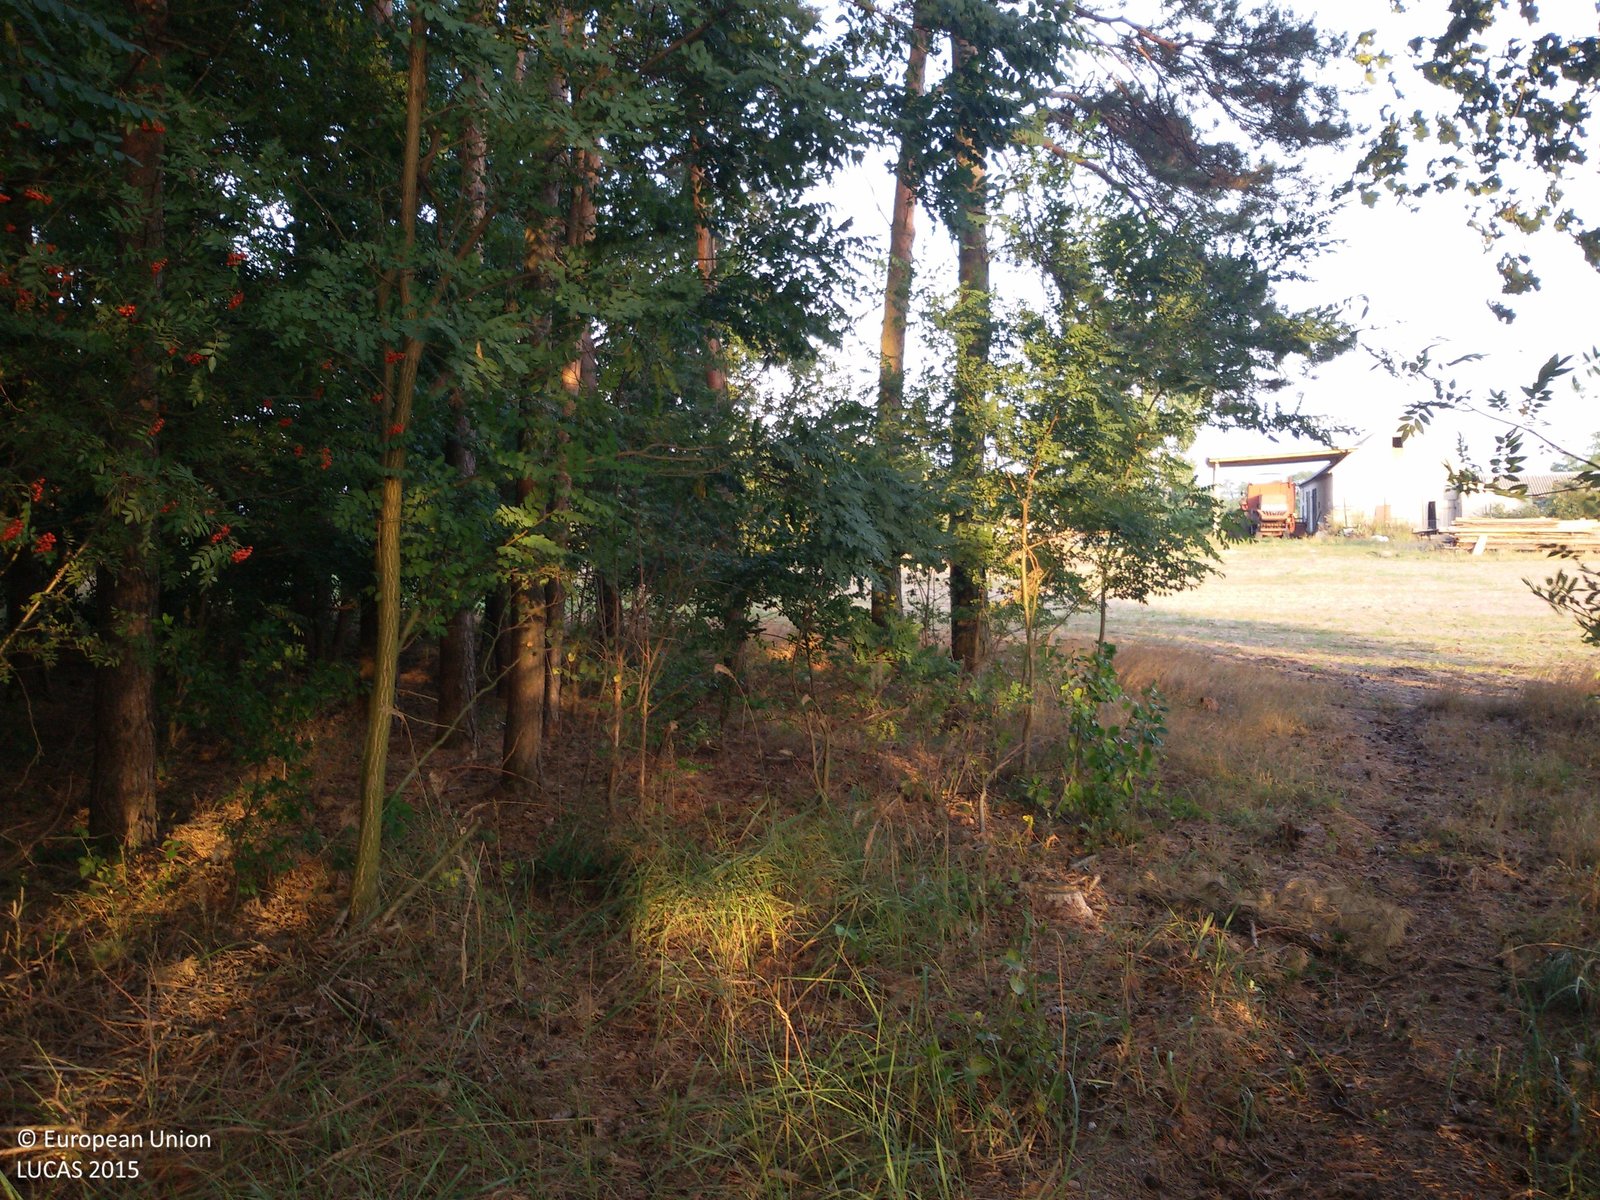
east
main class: Woodland
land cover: Pine dominated coniferous woodland
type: hemiboreal forest and nemoral coniferous forest and mixed broadleaved-coniferous forest
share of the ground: > 75 %
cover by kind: coniferous forest trees 60 %, broadleaved forest trees 20 %, herbaceous plants 10 %, unconsolidated bare surface 10 %
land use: Forestry
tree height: > 5 m
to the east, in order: Pine dominated coniferous woodland; Dry pulses; Grass margins; Pine dominated coniferous woodland; Rape and turnip rape
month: September
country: PL
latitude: 52.4145
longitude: 17.9989
